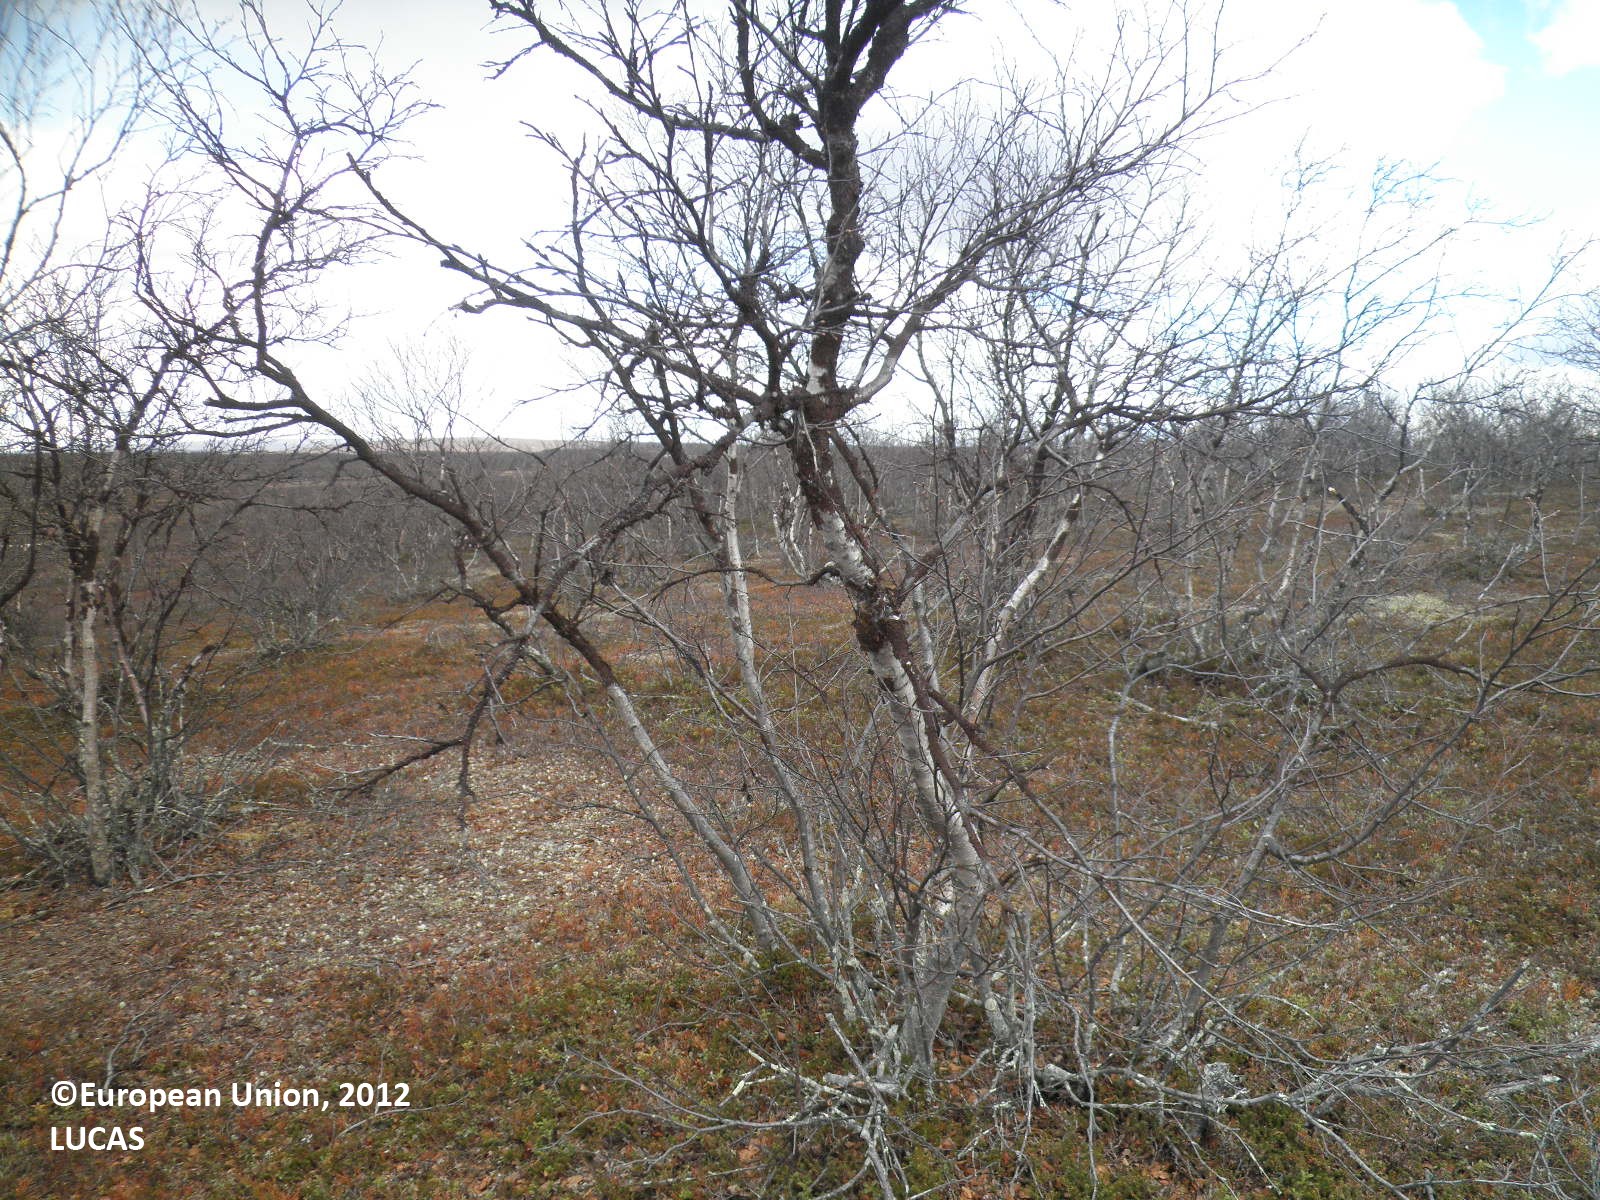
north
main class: Woodland
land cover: Broadleaved woodland
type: boreal forest
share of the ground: 10 - 25 %
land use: Semi-natural and natural areas not in use
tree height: > 5 m
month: May
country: FI
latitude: 69.4700
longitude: 27.2504
